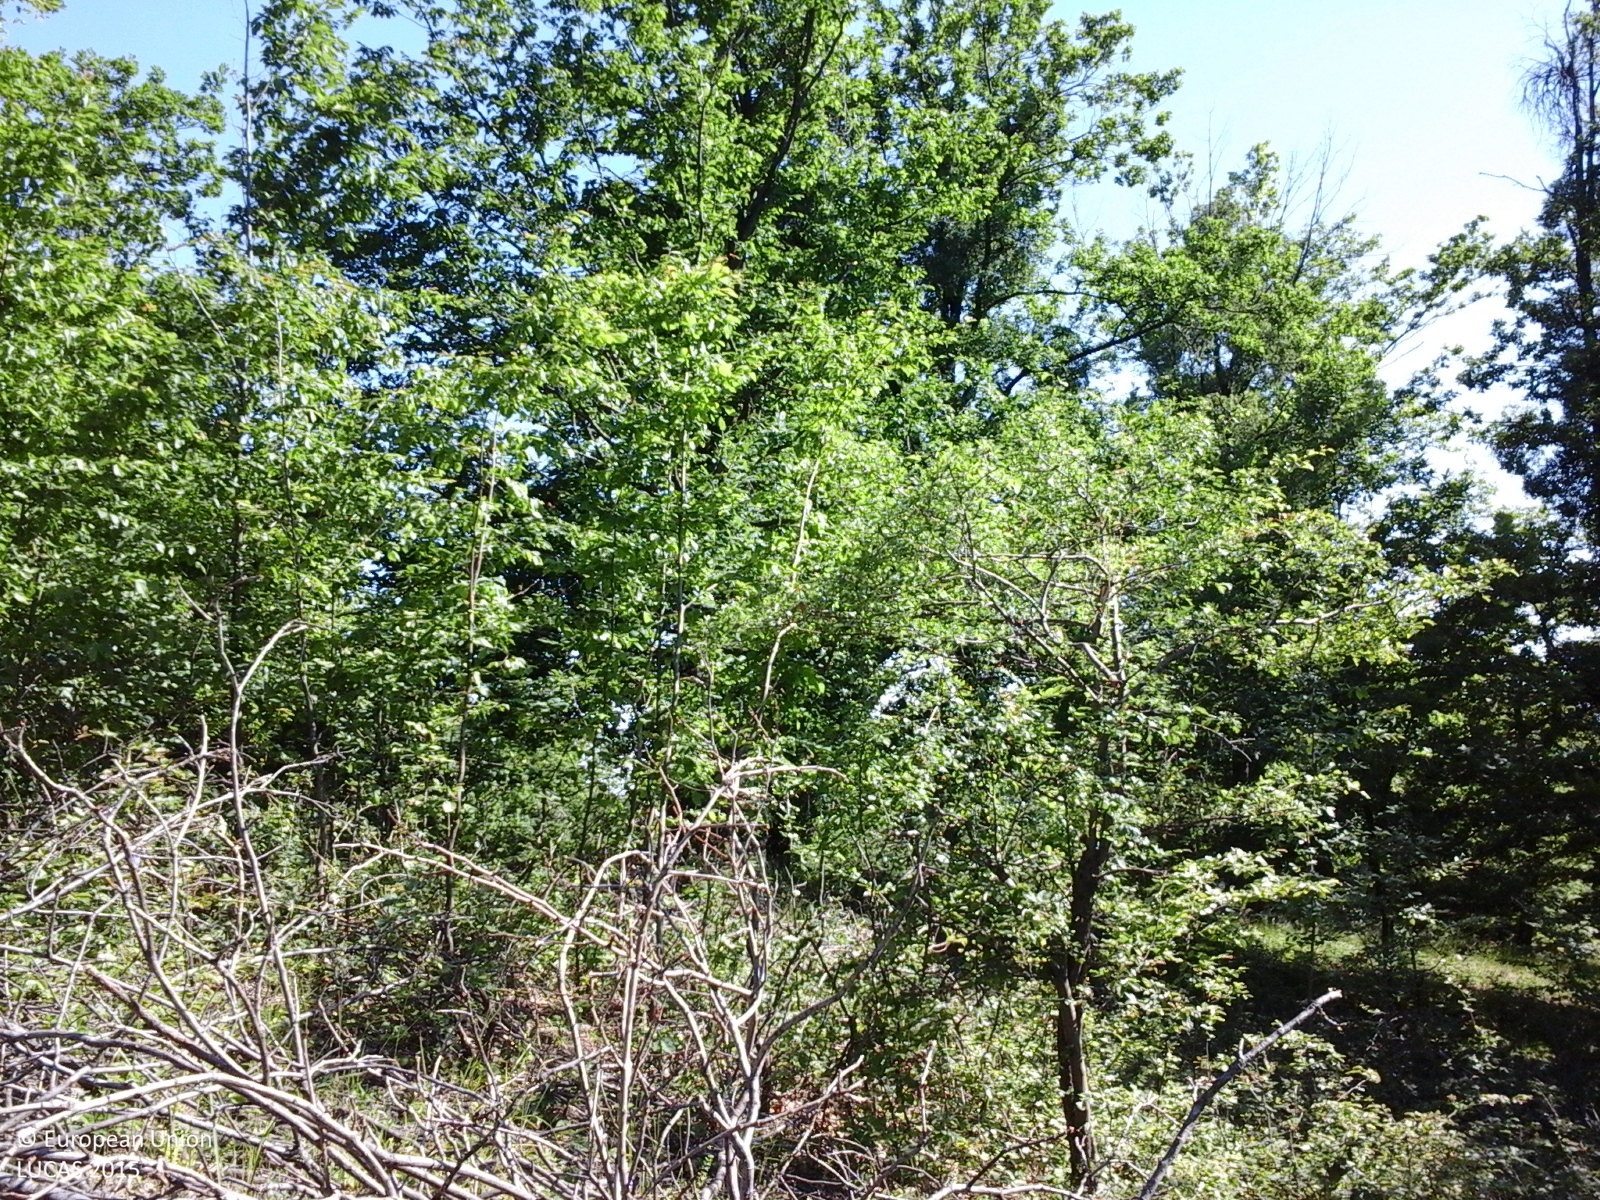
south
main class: Woodland
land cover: Broadleaved woodland
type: acidophilous oak and oak-birch forest
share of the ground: > 75 %
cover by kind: broadleaved forest trees 90 %, shrubs 10 %
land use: Forestry
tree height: > 5 m
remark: Clear cut
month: June
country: RO
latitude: 45.1297
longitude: 25.8073
